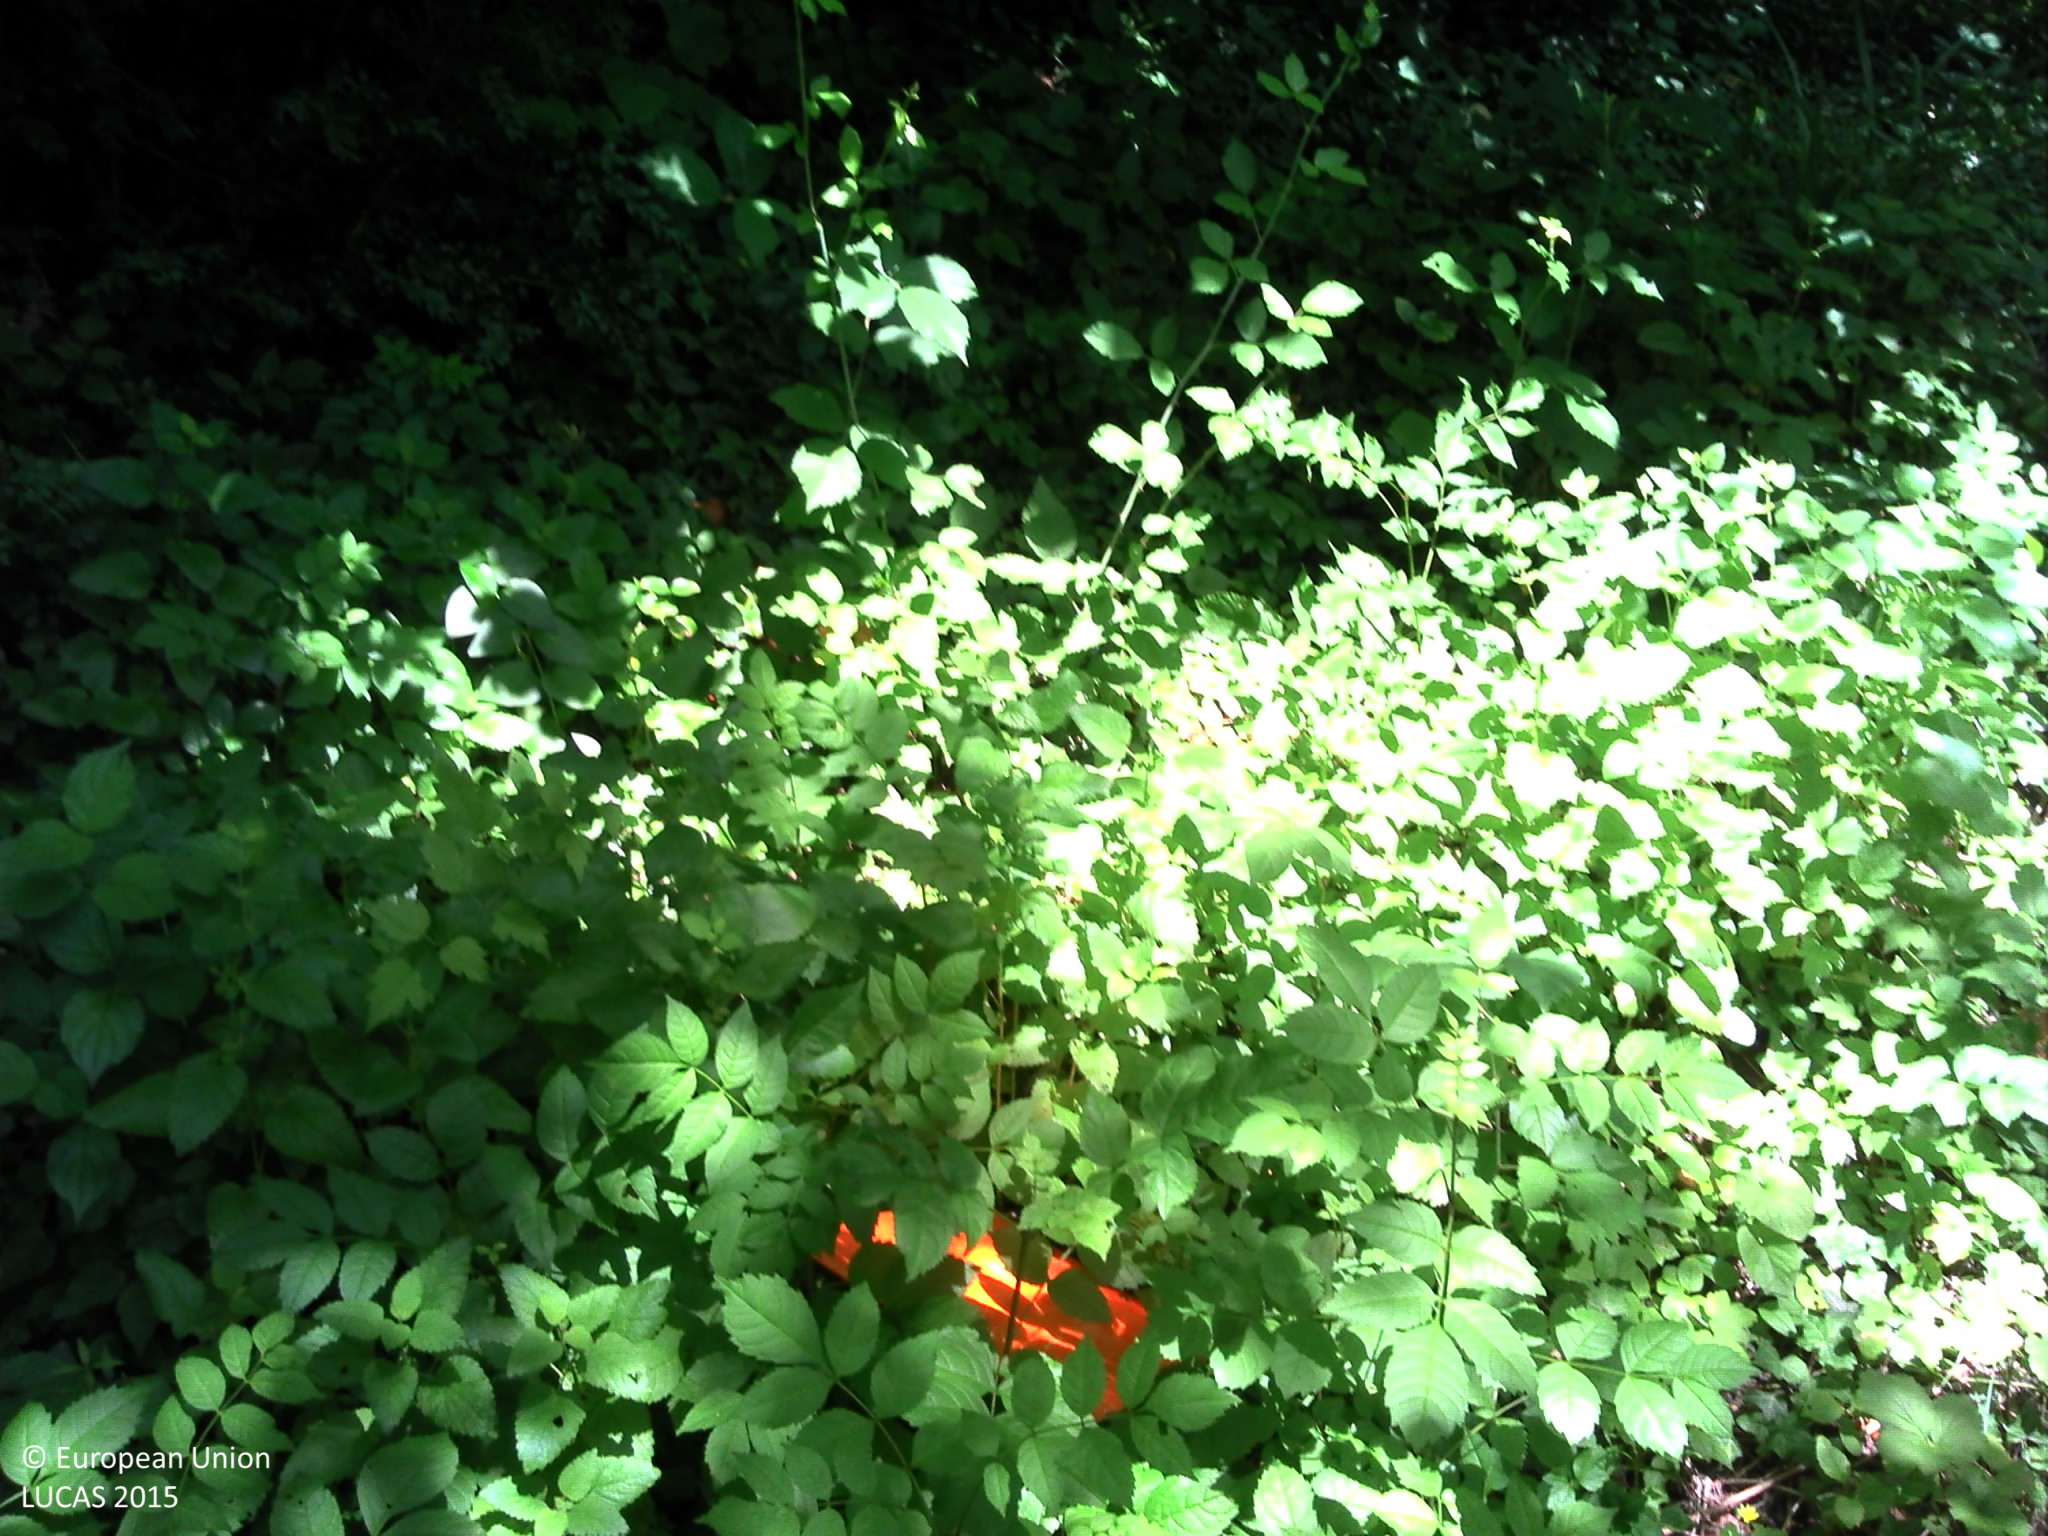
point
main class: Woodland
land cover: Broadleaved woodland
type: mesophytic deciduous forest
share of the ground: > 75 %
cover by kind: broadleaved forest trees 70 %, coniferous forest trees 10 %, shrubs 10 %, herbaceous plants 10 %
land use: Semi-natural and natural areas not in use
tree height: > 5 m
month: June
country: FR
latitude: 44.7379
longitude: 5.0434
